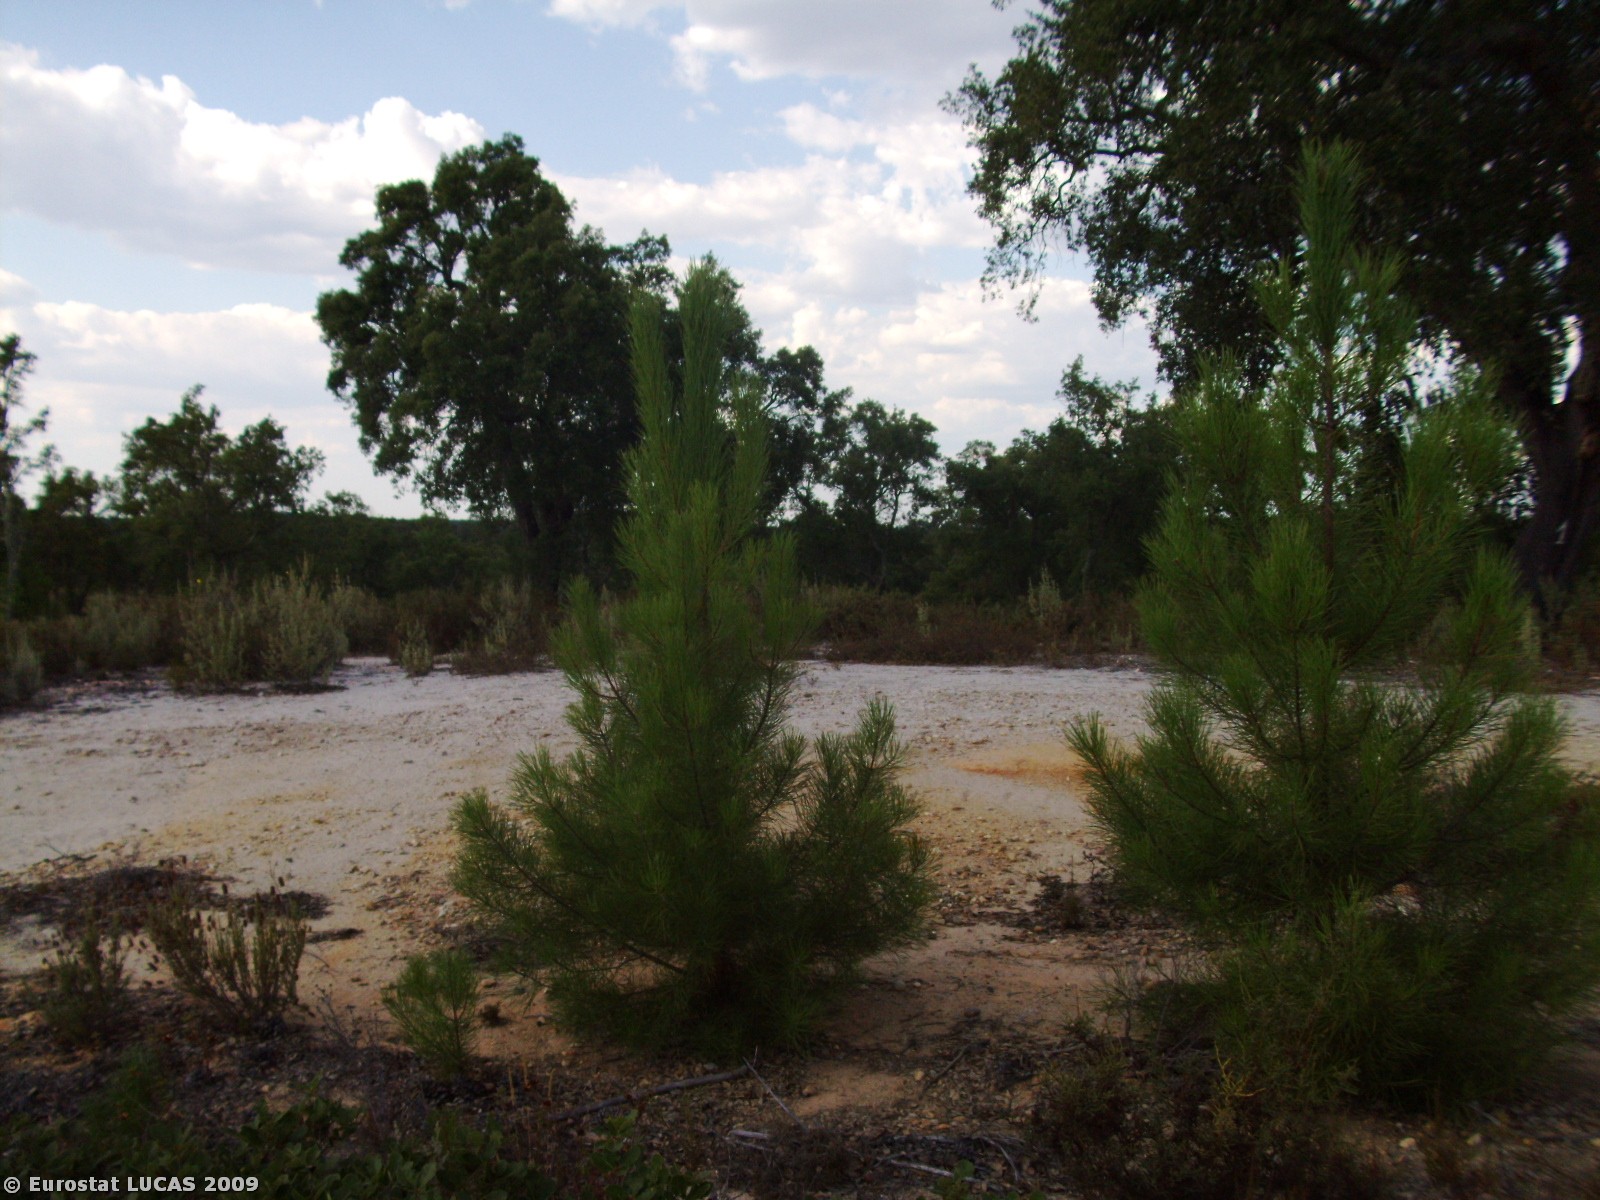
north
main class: Woodland
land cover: Mixed woodland
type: hemiboreal forest and nemoral coniferous forest and mixed broadleaved-coniferous forest
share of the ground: 10 - 25 %
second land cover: Spontaneously vegetated surfaces
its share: 50 - 75 %
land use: Forestry
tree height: > 5 m
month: August
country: PT
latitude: 39.1951
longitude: -8.1073
